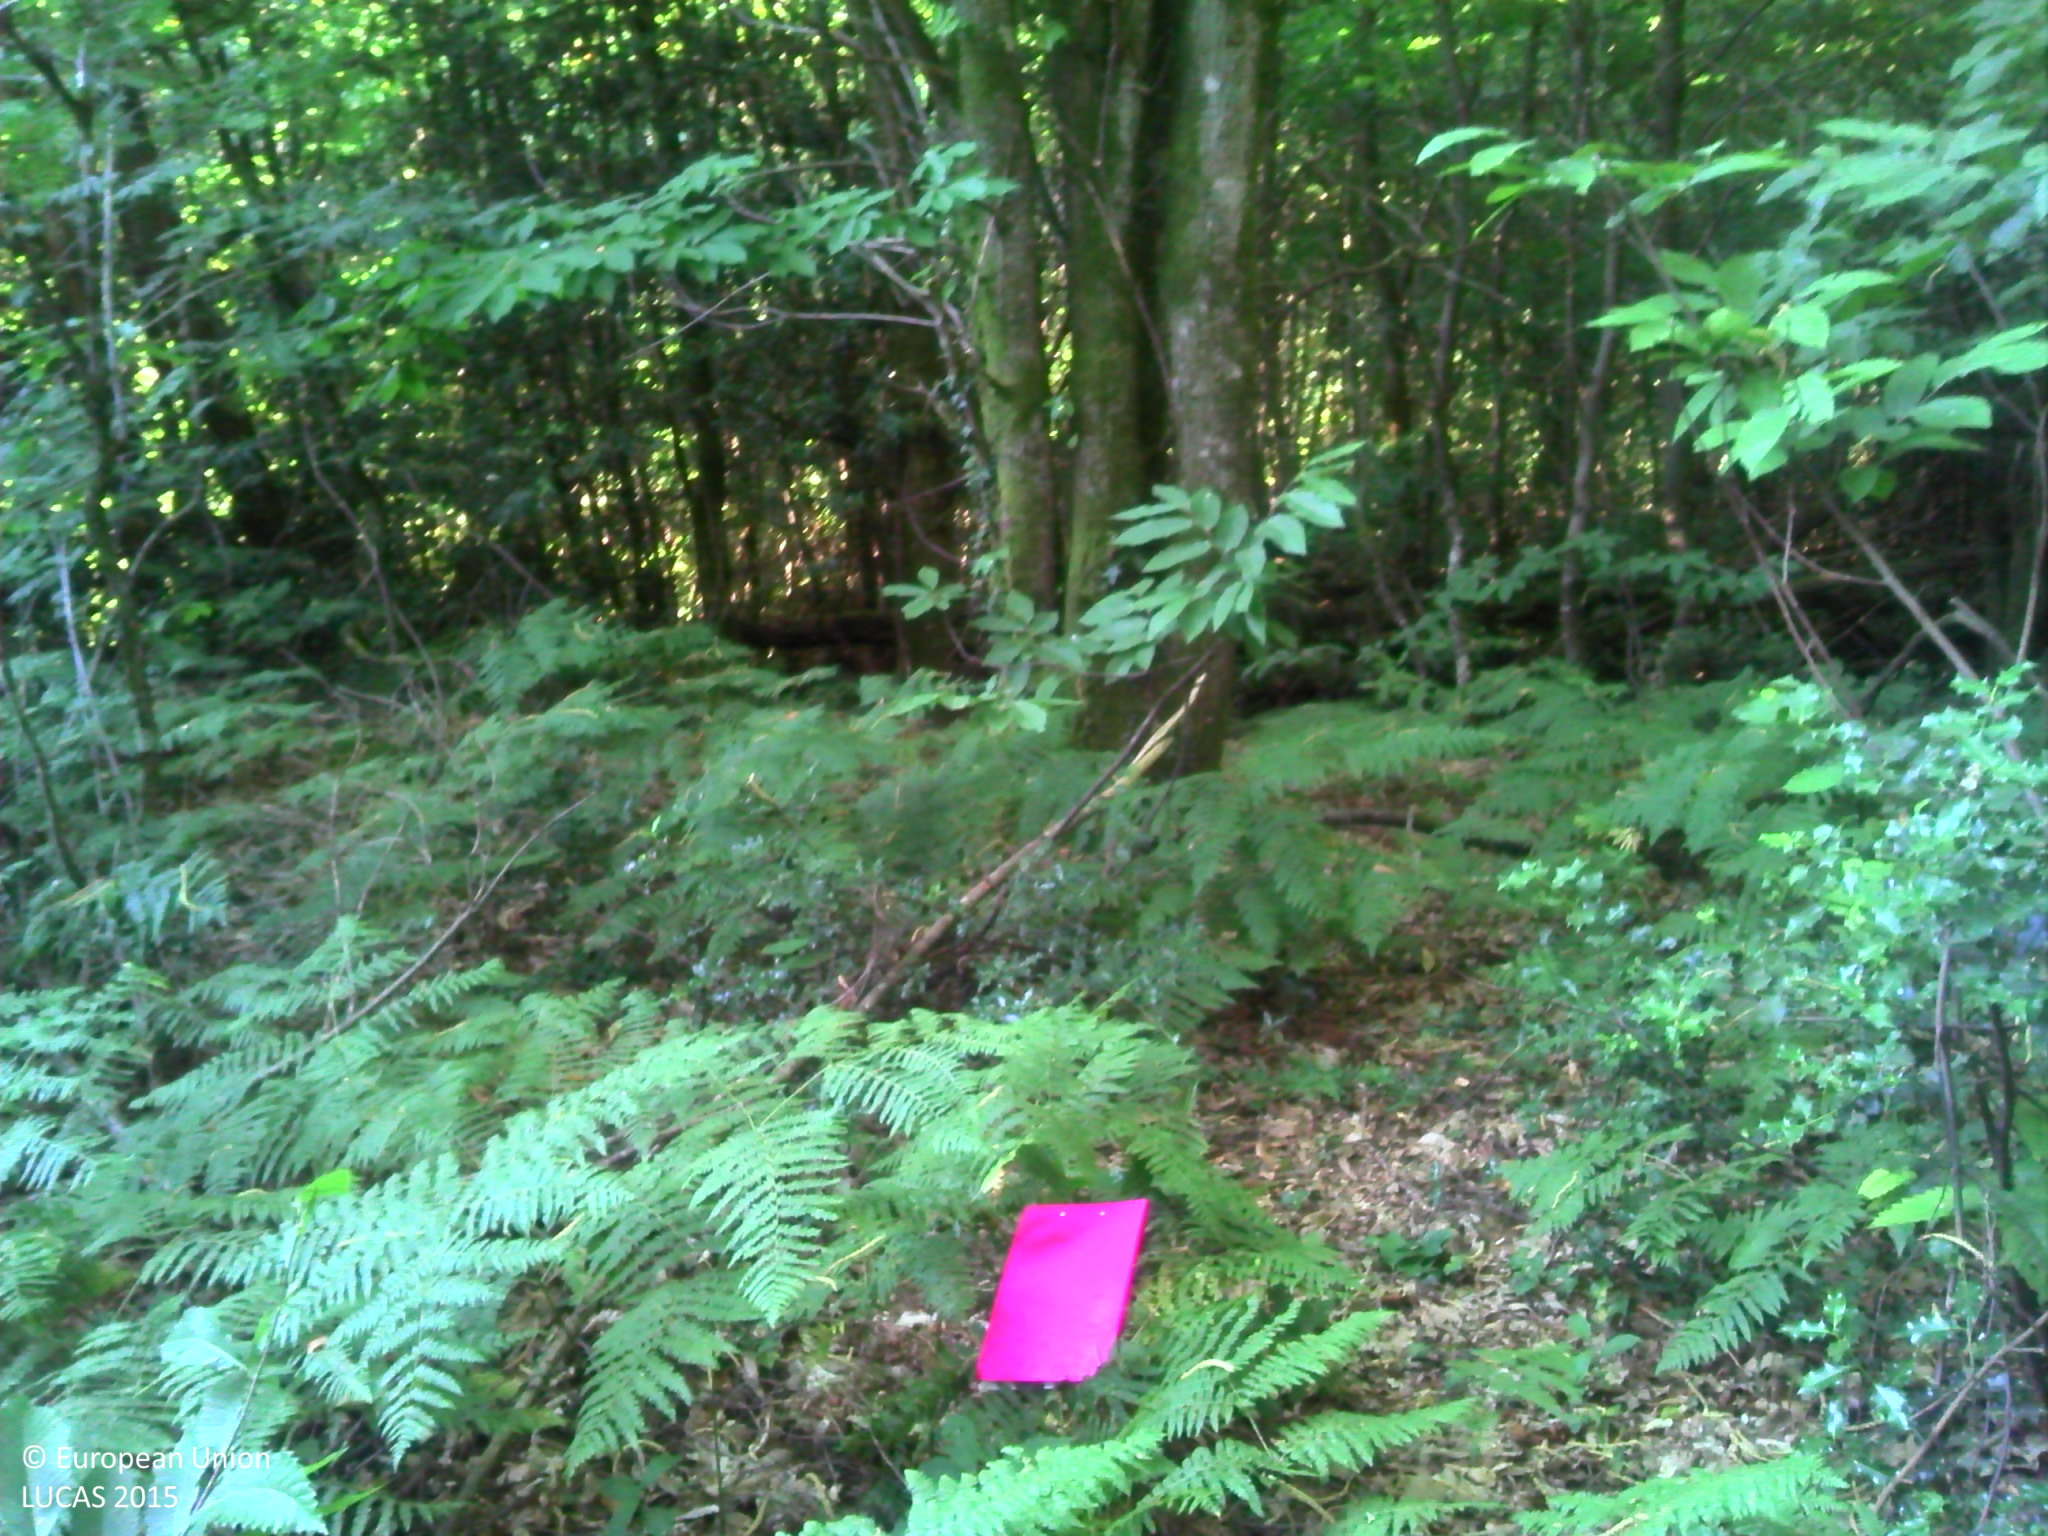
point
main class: Woodland
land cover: Broadleaved woodland
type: mesophytic deciduous forest
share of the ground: > 75 %
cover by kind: broadleaved forest trees 80 %, shrubs 10 %, herbaceous plants 10 %
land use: Forestry
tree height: > 5 m
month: July
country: FR
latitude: 46.2157
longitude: 1.5522
